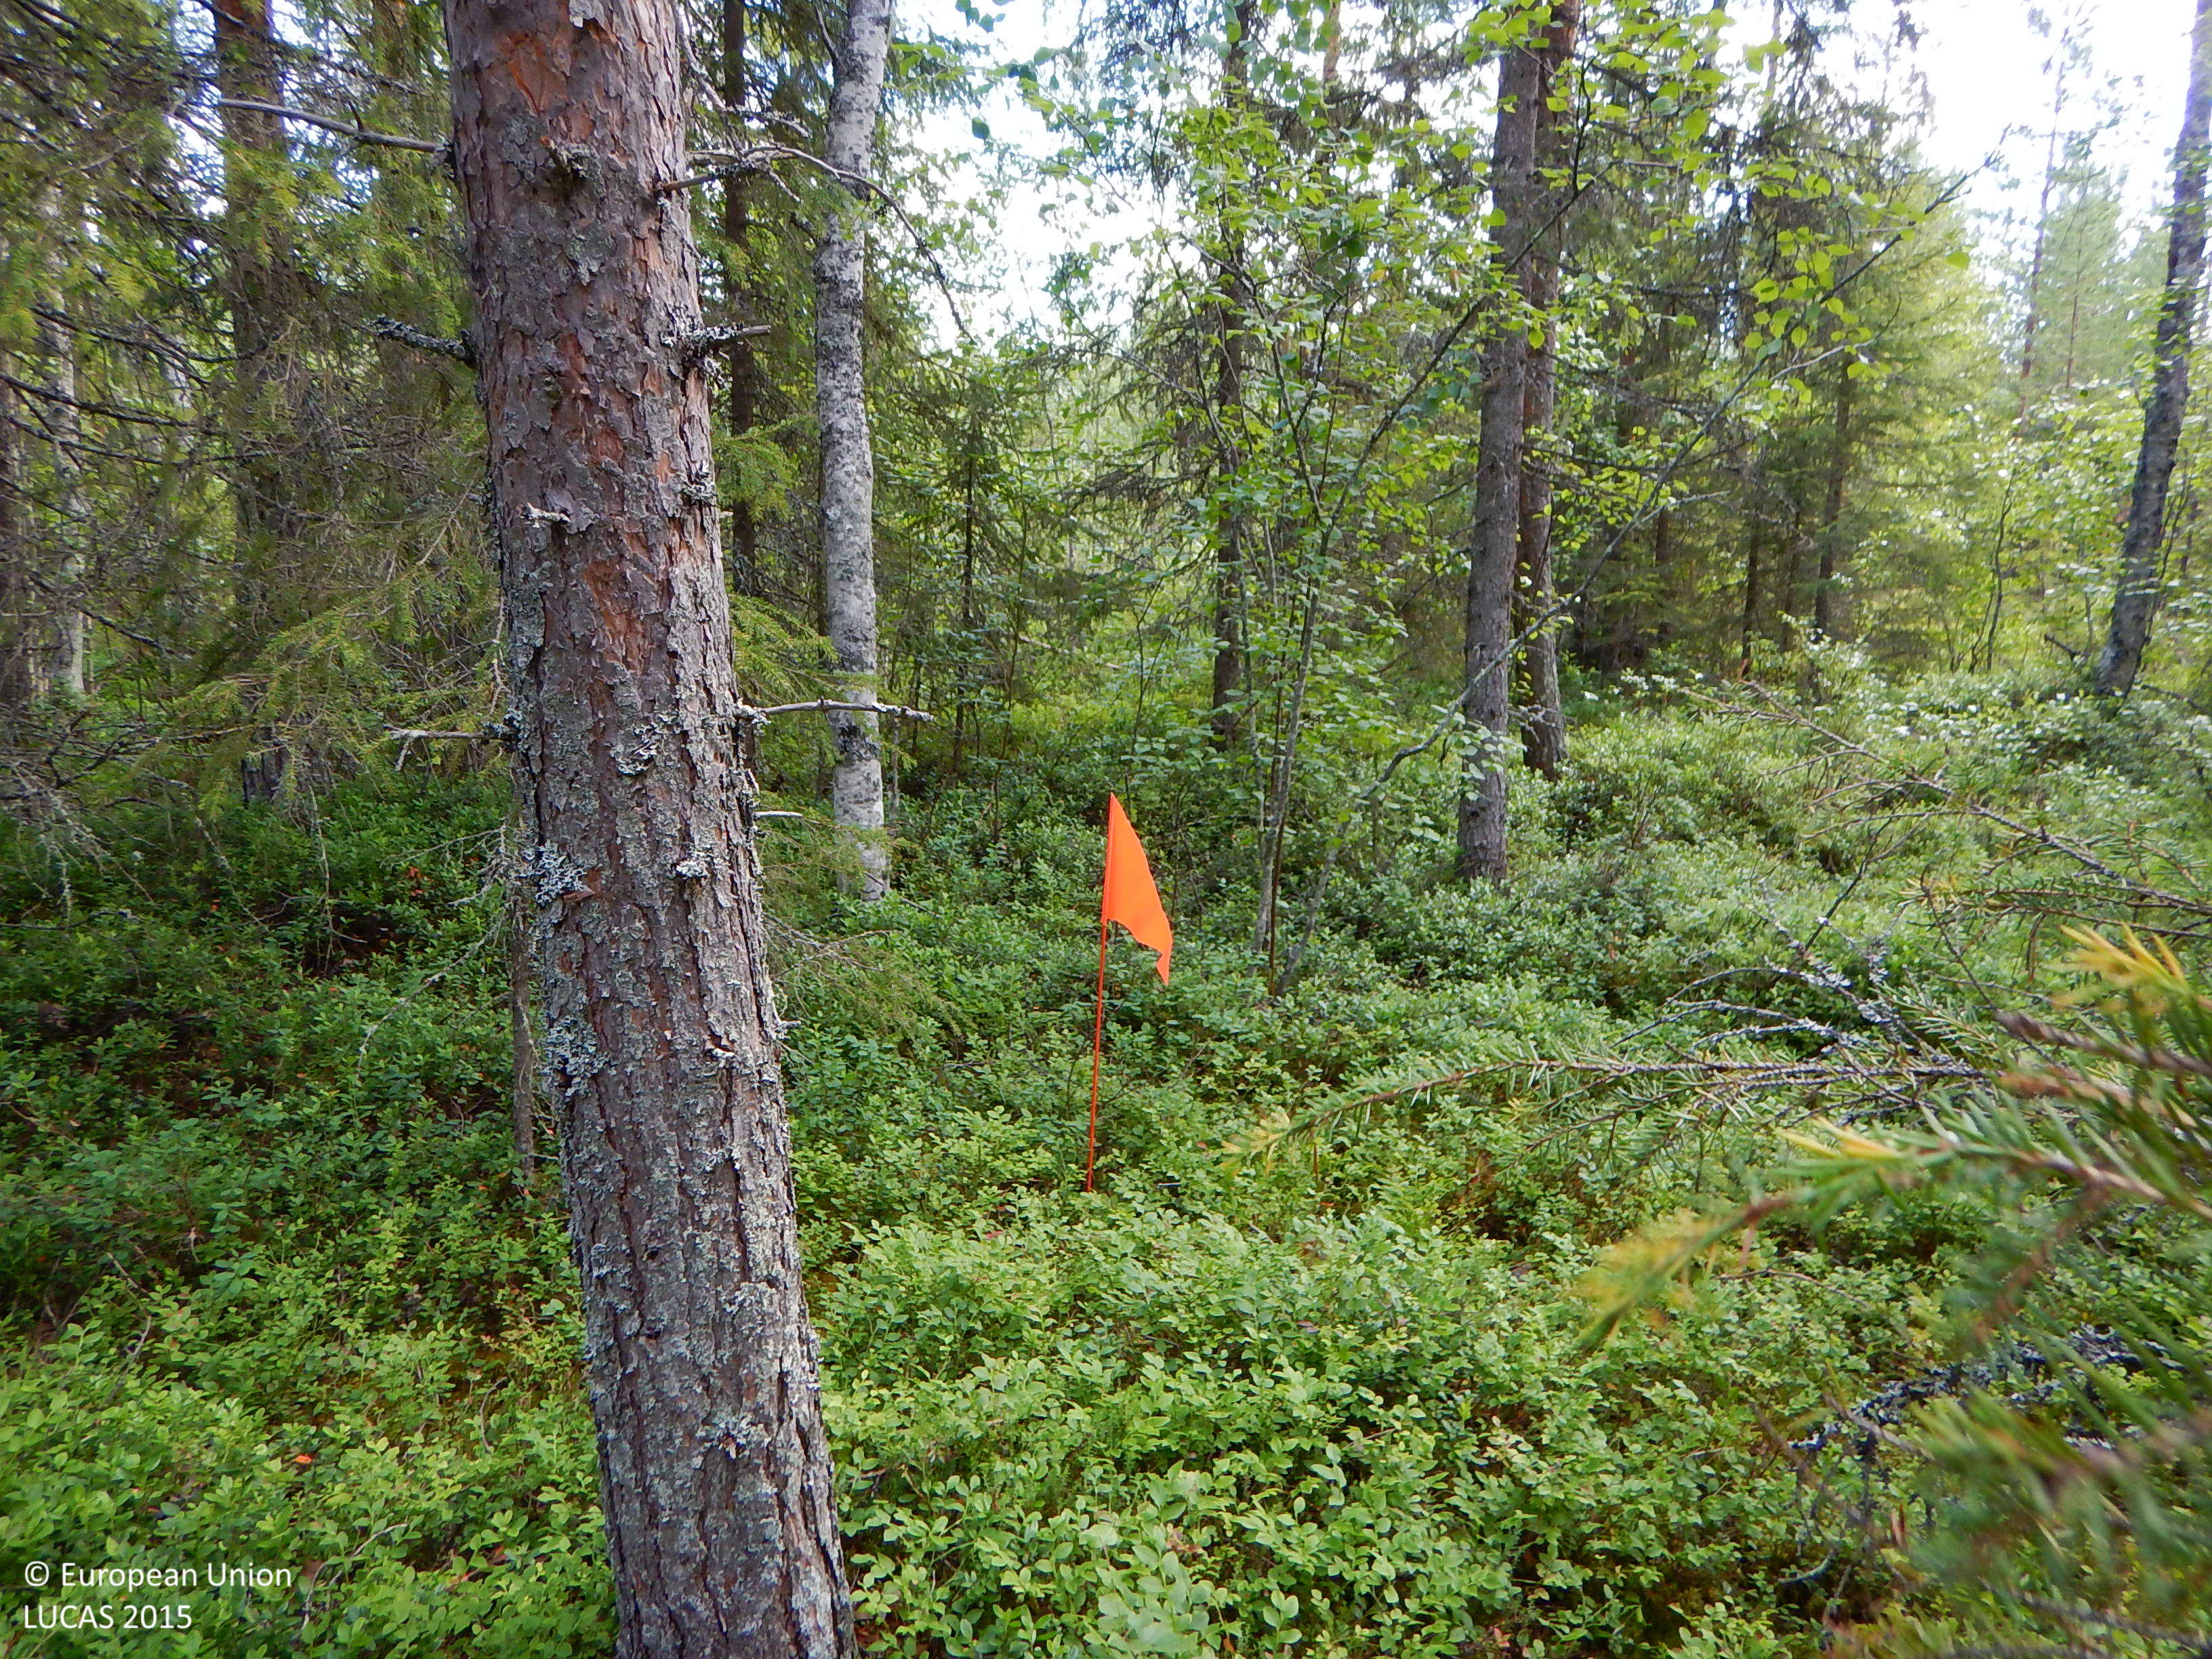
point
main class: Woodland
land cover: Other coniferous woodland
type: boreal forest
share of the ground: 50 - 75 %
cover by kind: coniferous forest trees 60 %, shrubs 15 %, herbaceous plants 10 %, lichens and mosses 10 %, broadleaved forest trees 5 %
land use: Forestry
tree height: > 5 m
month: July
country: SE
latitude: 64.8712
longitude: 20.2077
